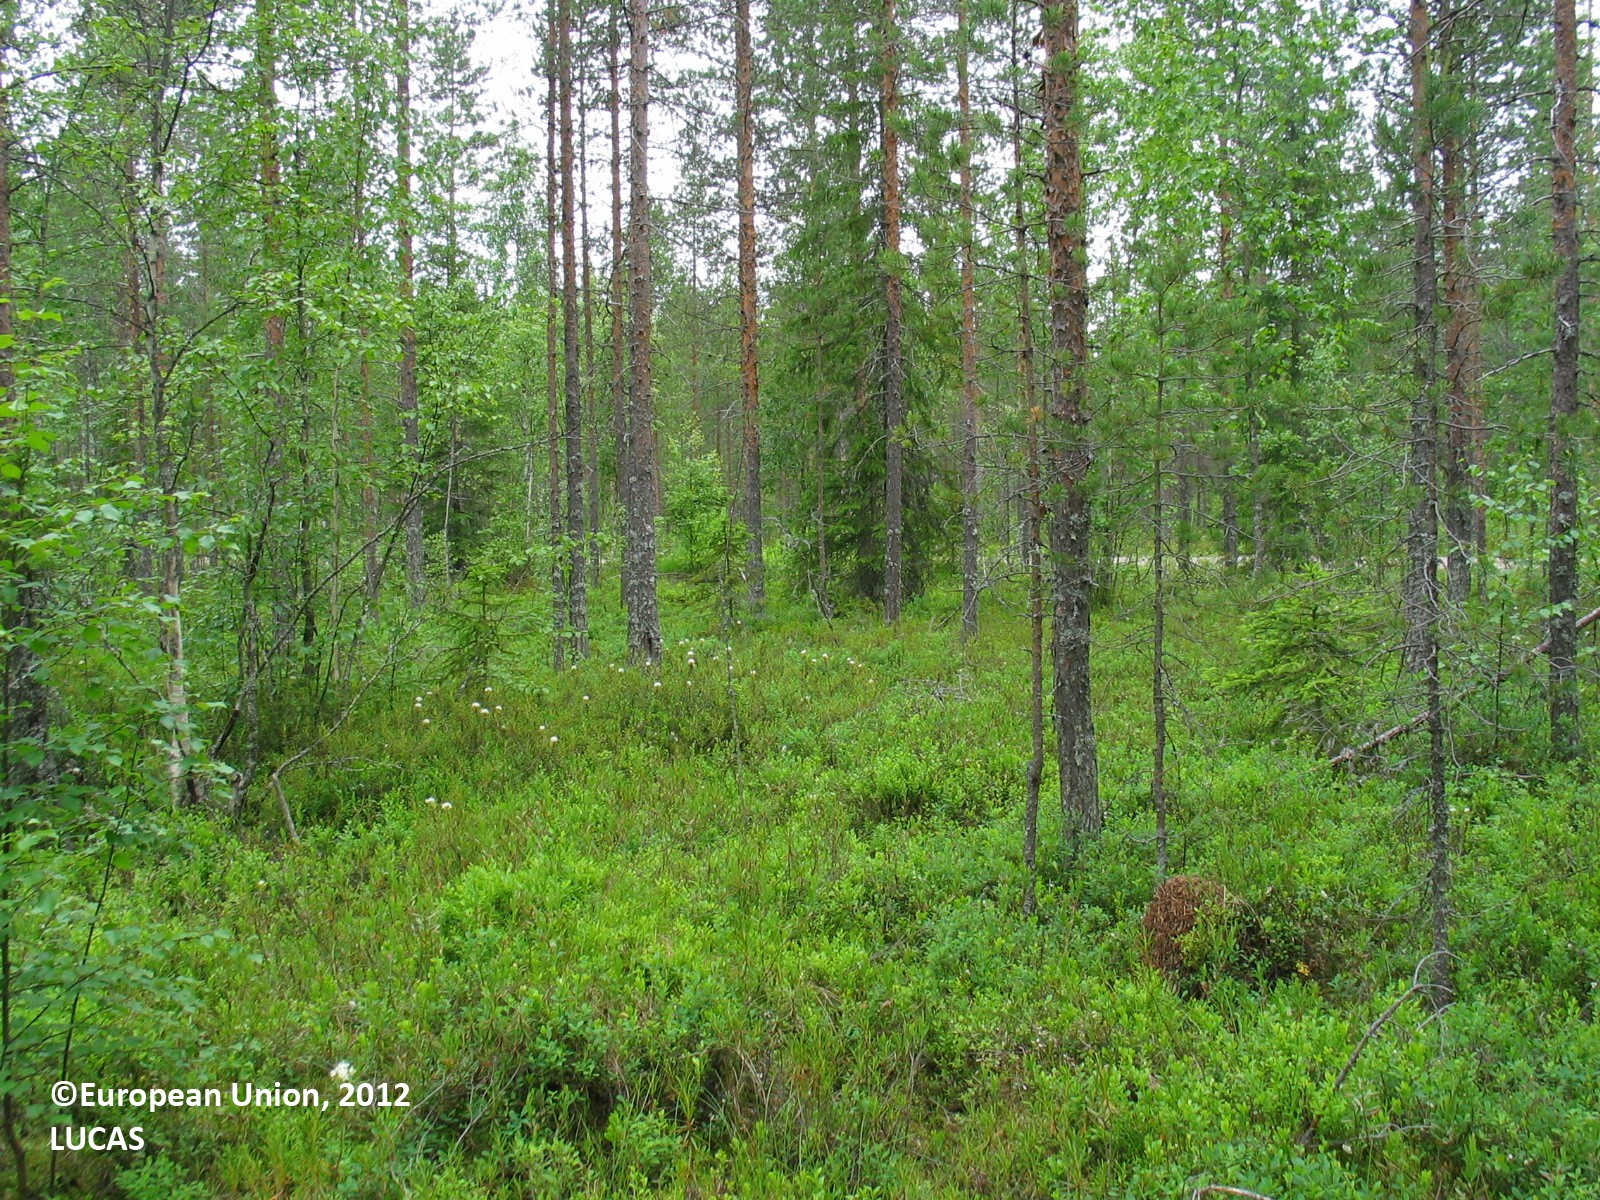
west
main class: Woodland
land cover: Pine dominated coniferous woodland
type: mire and swamp forests
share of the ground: 25 - 50 %
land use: Forestry
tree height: > 5 m
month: July
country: FI
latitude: 64.6474
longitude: 26.5879
